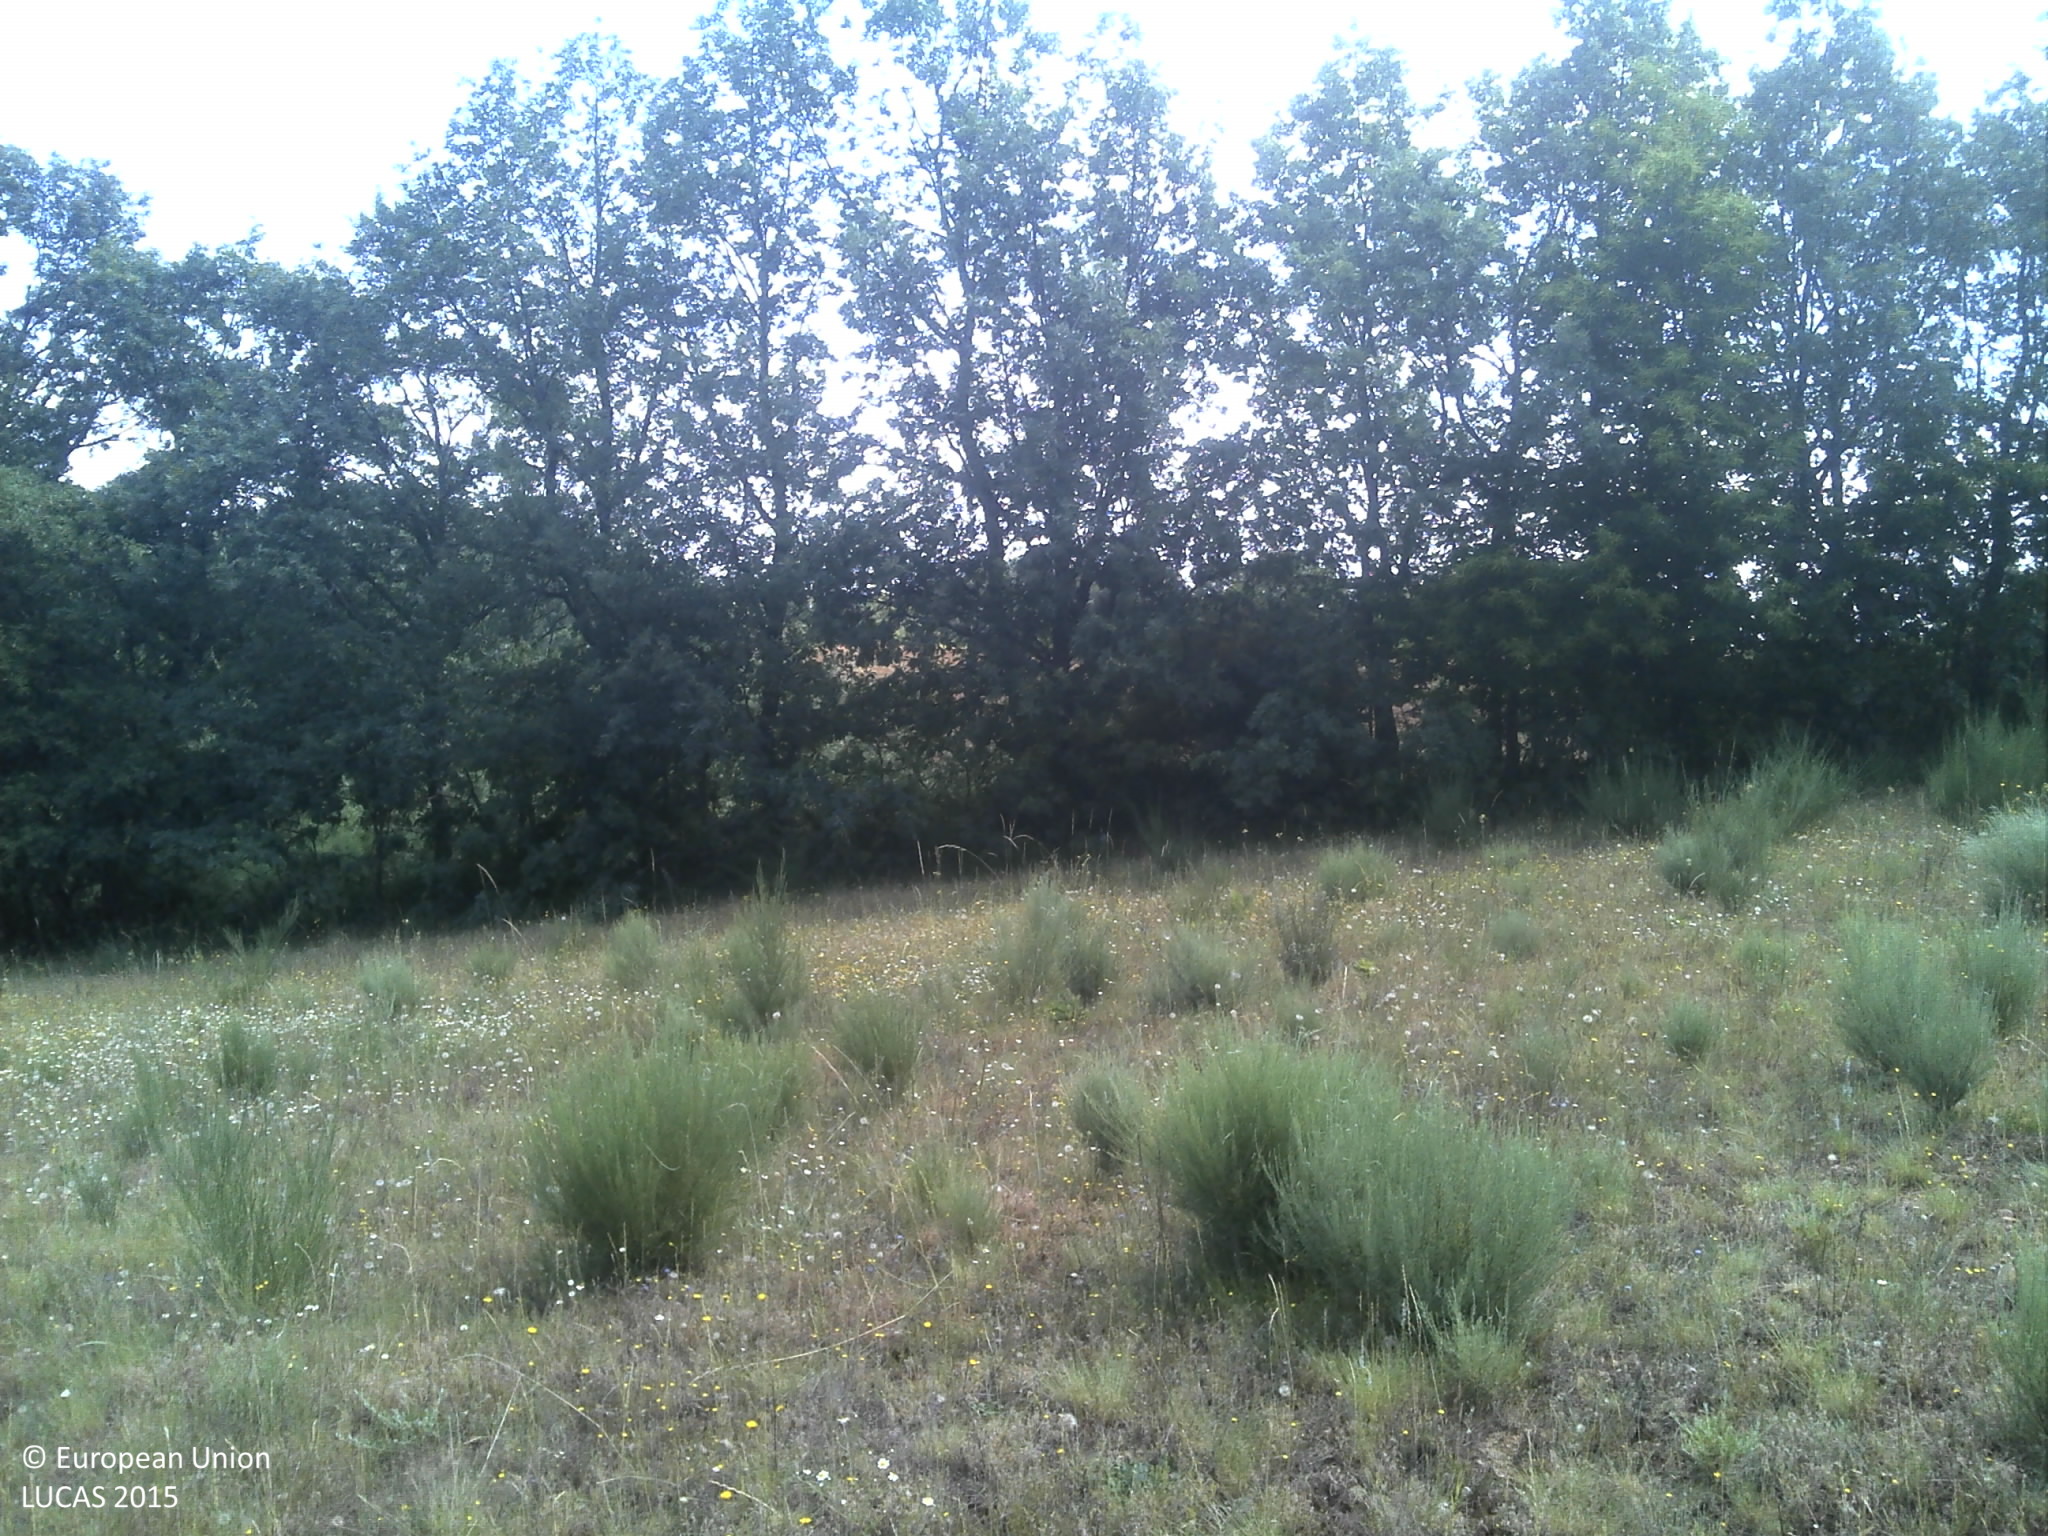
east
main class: Grassland
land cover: Grassland without tree/shrub cover
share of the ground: 25 - 50 %
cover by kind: herbaceous plants 50 %, unconsolidated bare surface 40 %, shrubs 5 %
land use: Agriculture (excluding fallow land and kitchen gardens)
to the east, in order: Grassland without tree/shrub cover; Abandoned hedges; Fences; Other bare soil; Fences; Shruby margins; Tracks; Abandoned hedges; Nuts trees; Rye
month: June
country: PT
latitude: 40.3446
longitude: -6.9657
